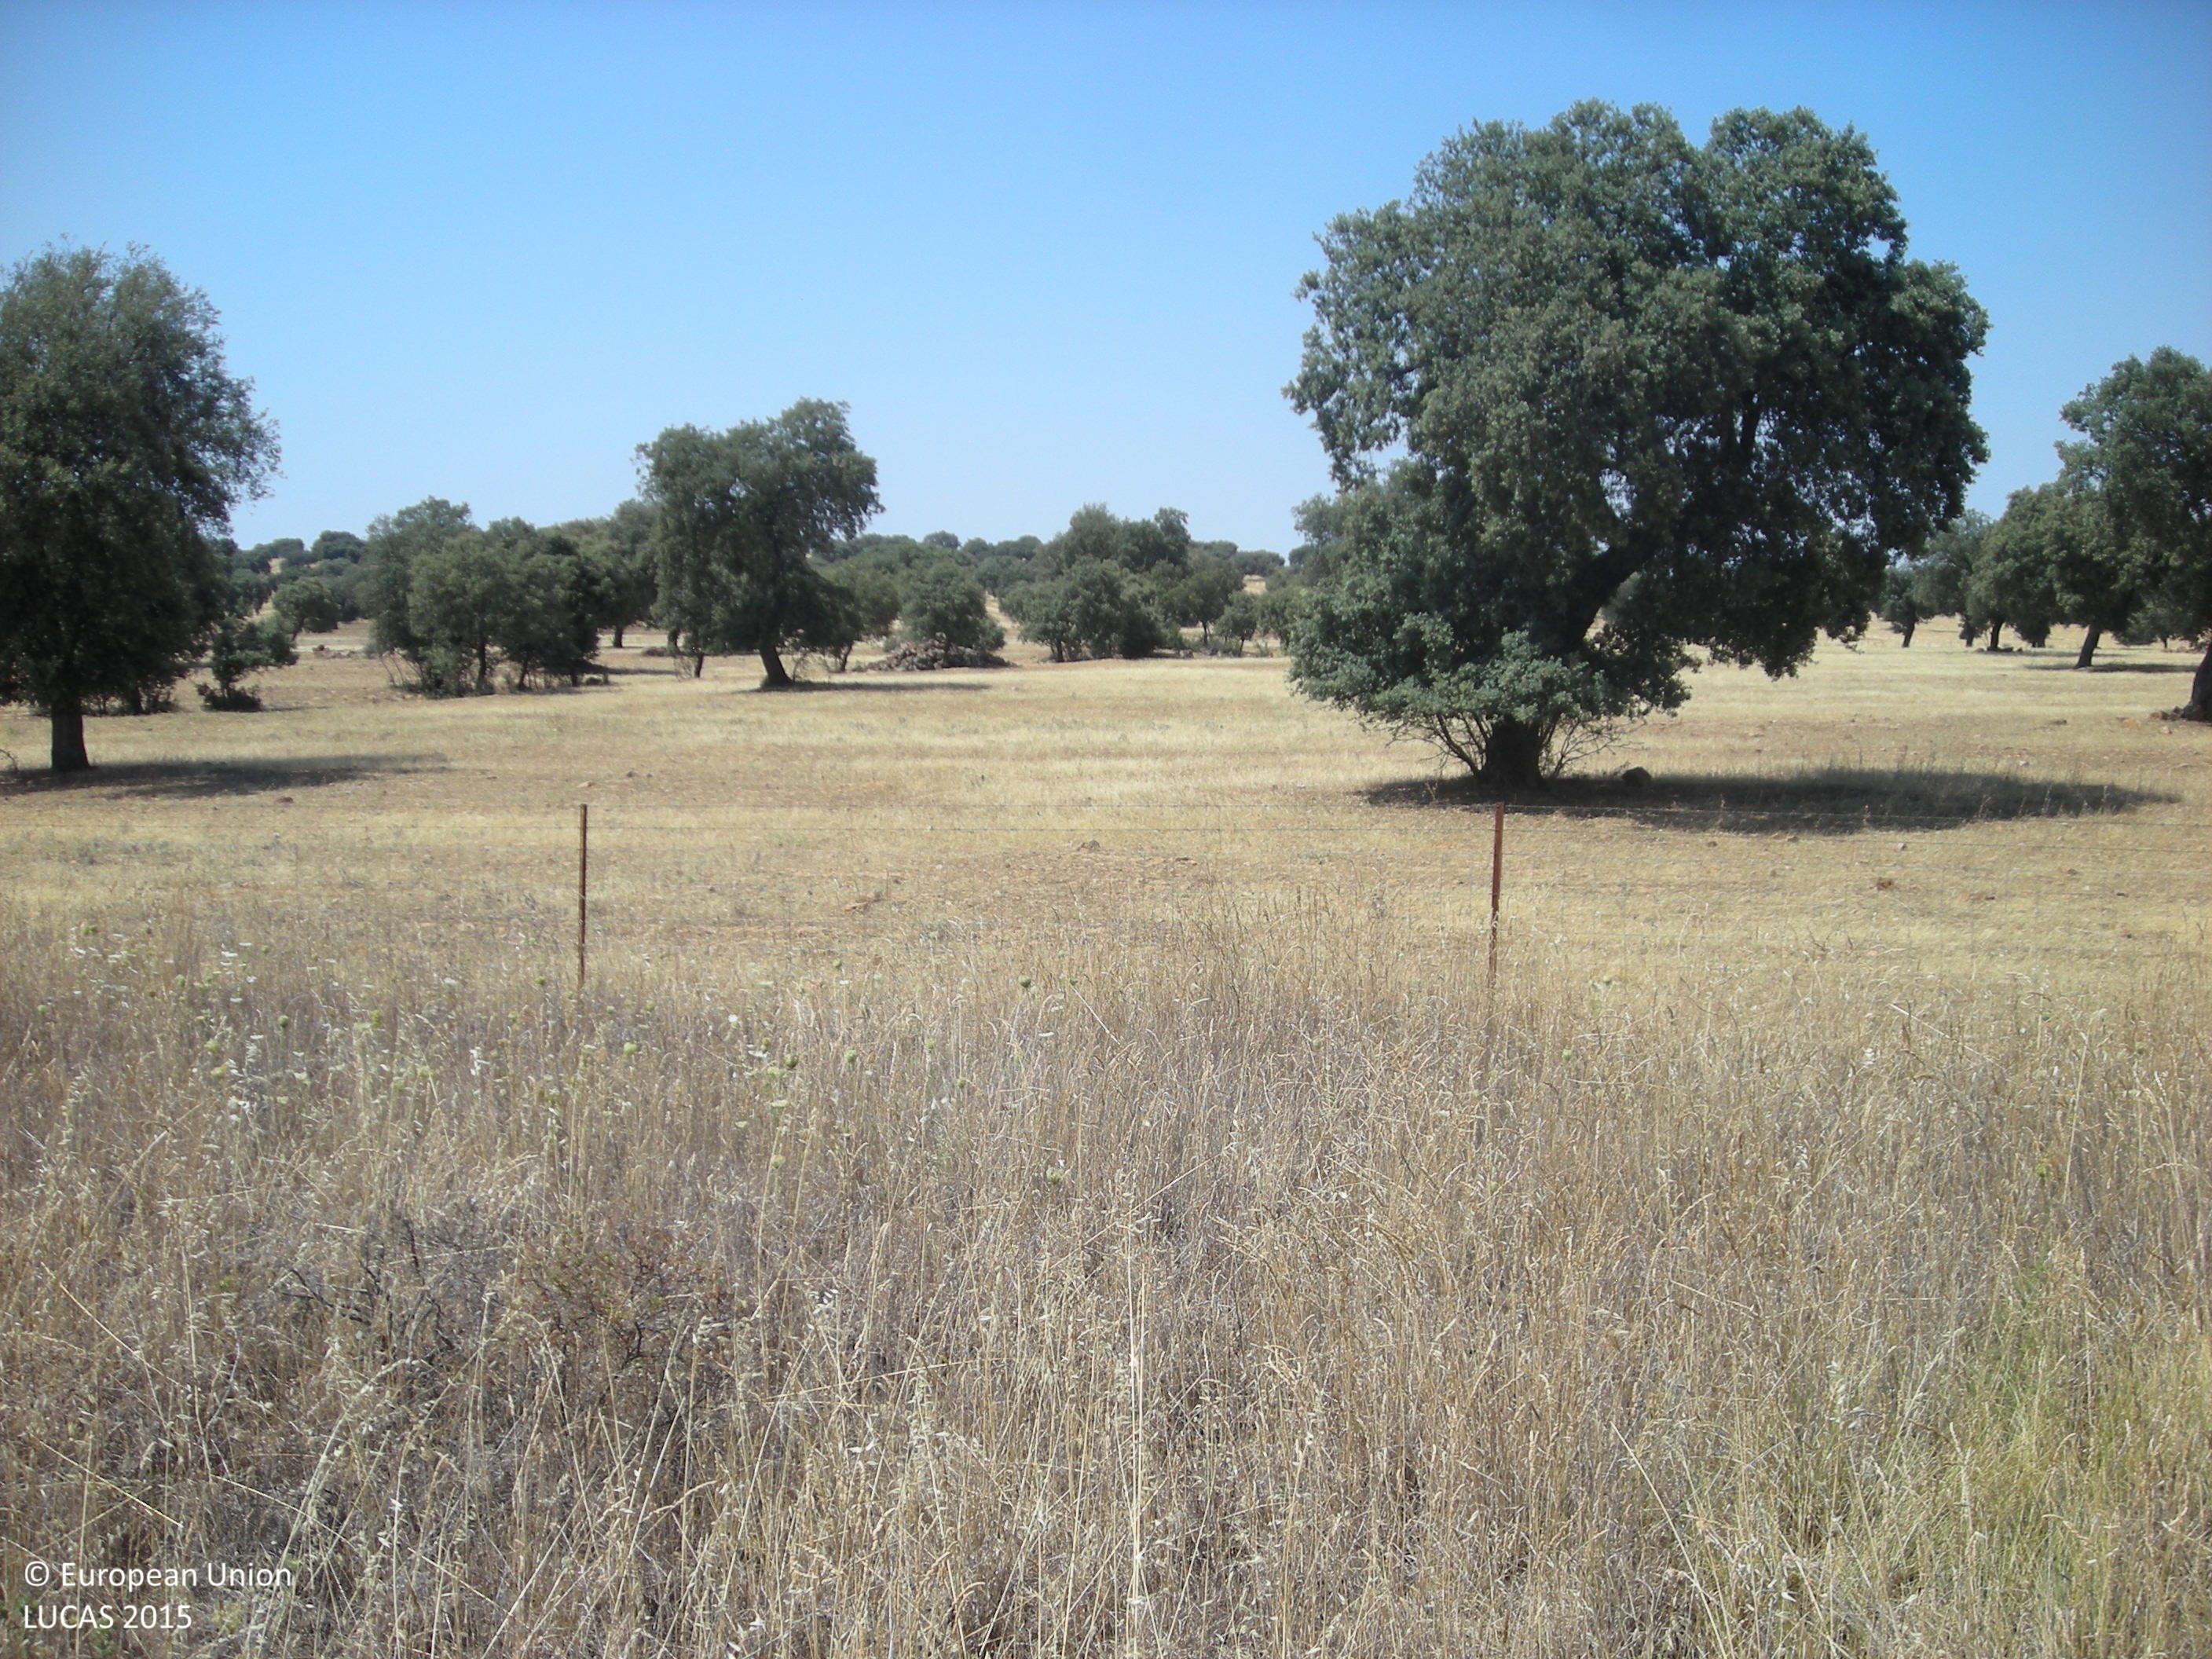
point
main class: Shrubland
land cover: Shrubland without tree cover
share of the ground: > 75 %
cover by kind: shrubs 100 %
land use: Semi-natural and natural areas not in use
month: June
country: ES
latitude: 38.6501
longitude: -5.8897
